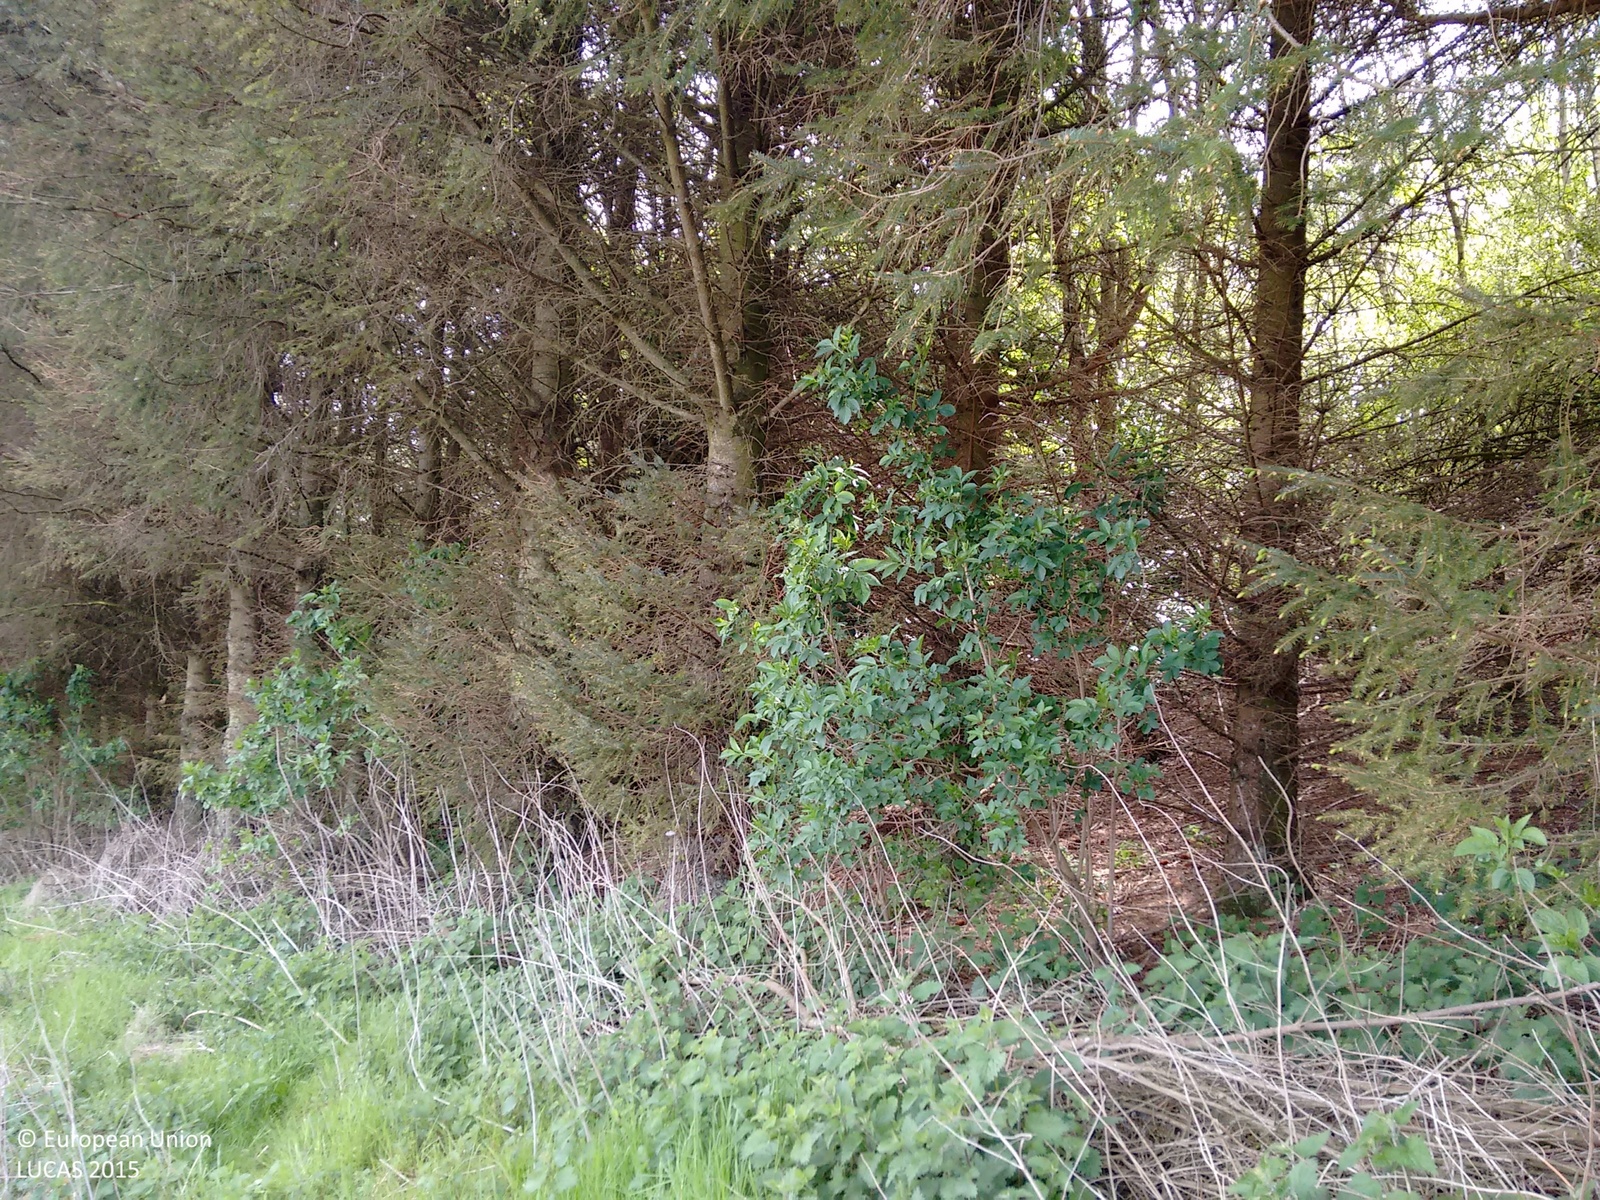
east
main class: Cropland
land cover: Dry pulses
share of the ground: < 10 %
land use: Agriculture (excluding fallow land and kitchen gardens)
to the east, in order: Grass margins; Other mixed woodland; Dry pulses
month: May
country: GB
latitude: 55.7914
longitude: -2.3218
